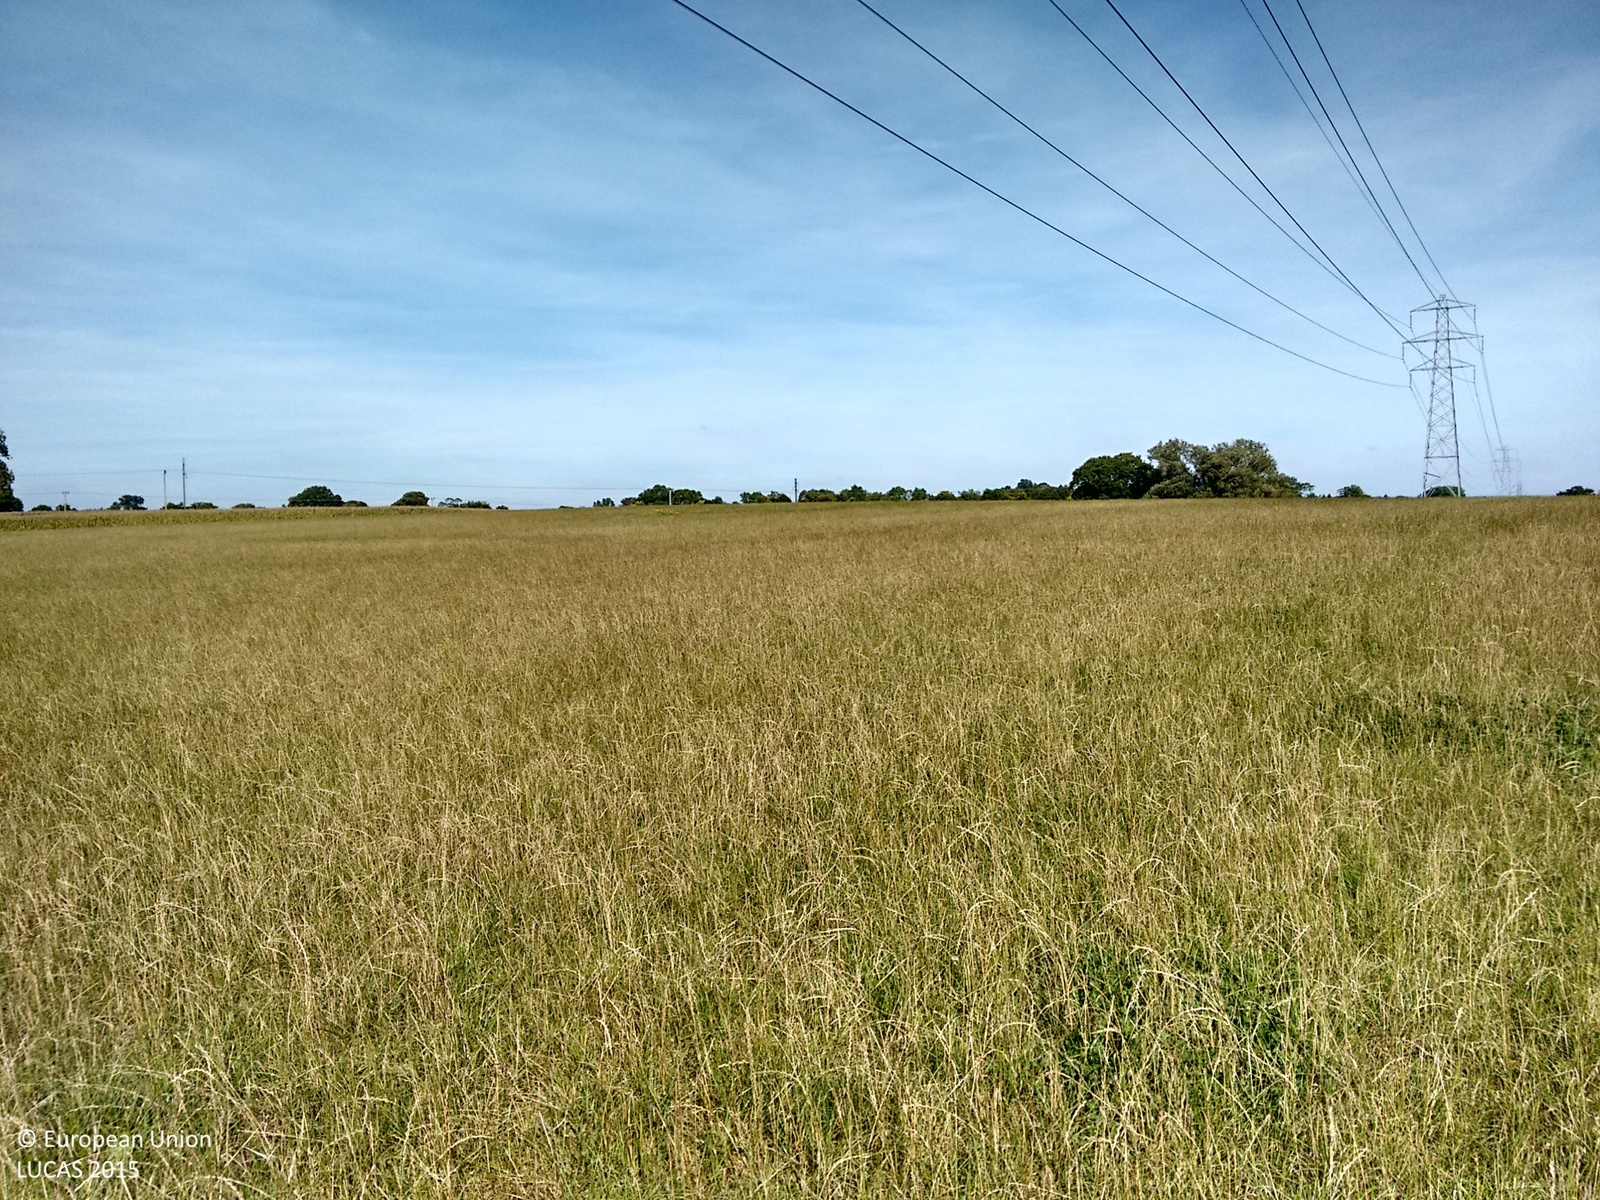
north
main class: Cropland
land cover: Temporary grasslands
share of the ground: > 75 %
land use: Agriculture (excluding fallow land and kitchen gardens)
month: September
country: GB
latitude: 51.6990
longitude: -2.4656
